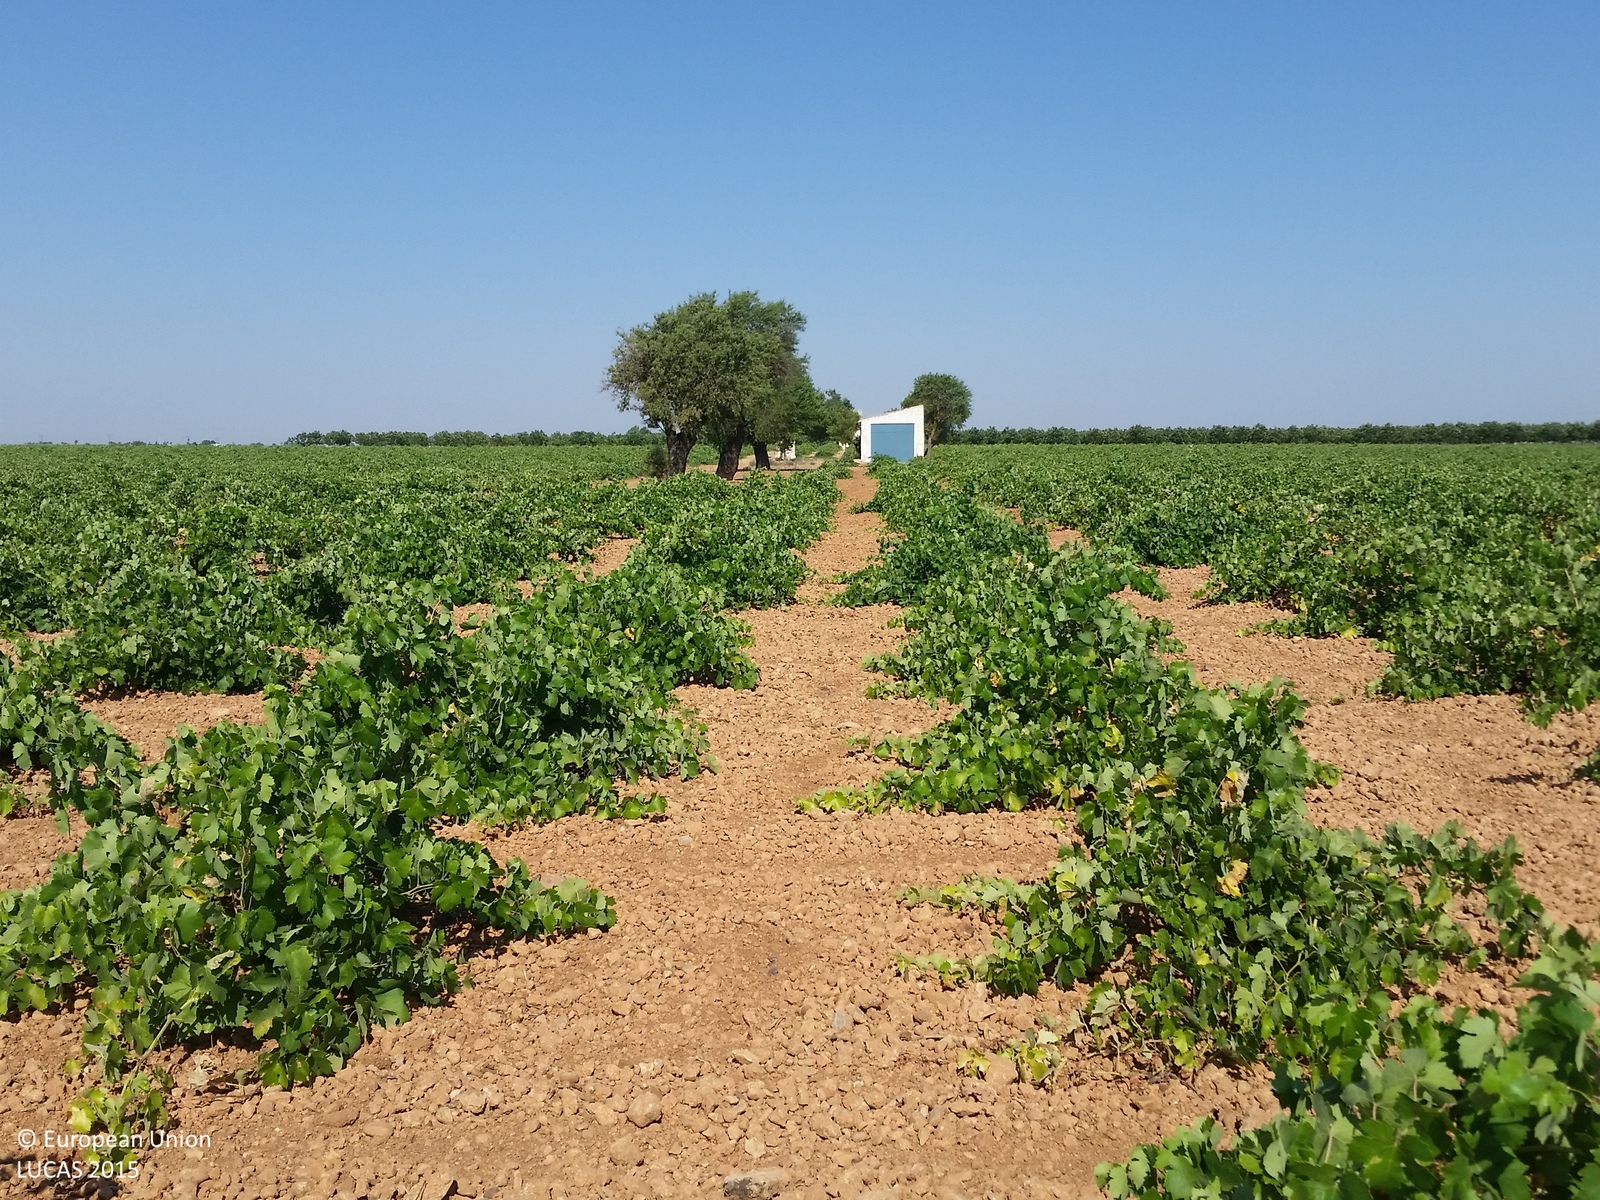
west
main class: Cropland
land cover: Vineyards
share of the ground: 50 - 75 %
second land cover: Other bare soil
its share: > 75 %
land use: Agriculture (excluding fallow land and kitchen gardens)
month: July
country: ES
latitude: 39.2406
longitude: -2.5336
